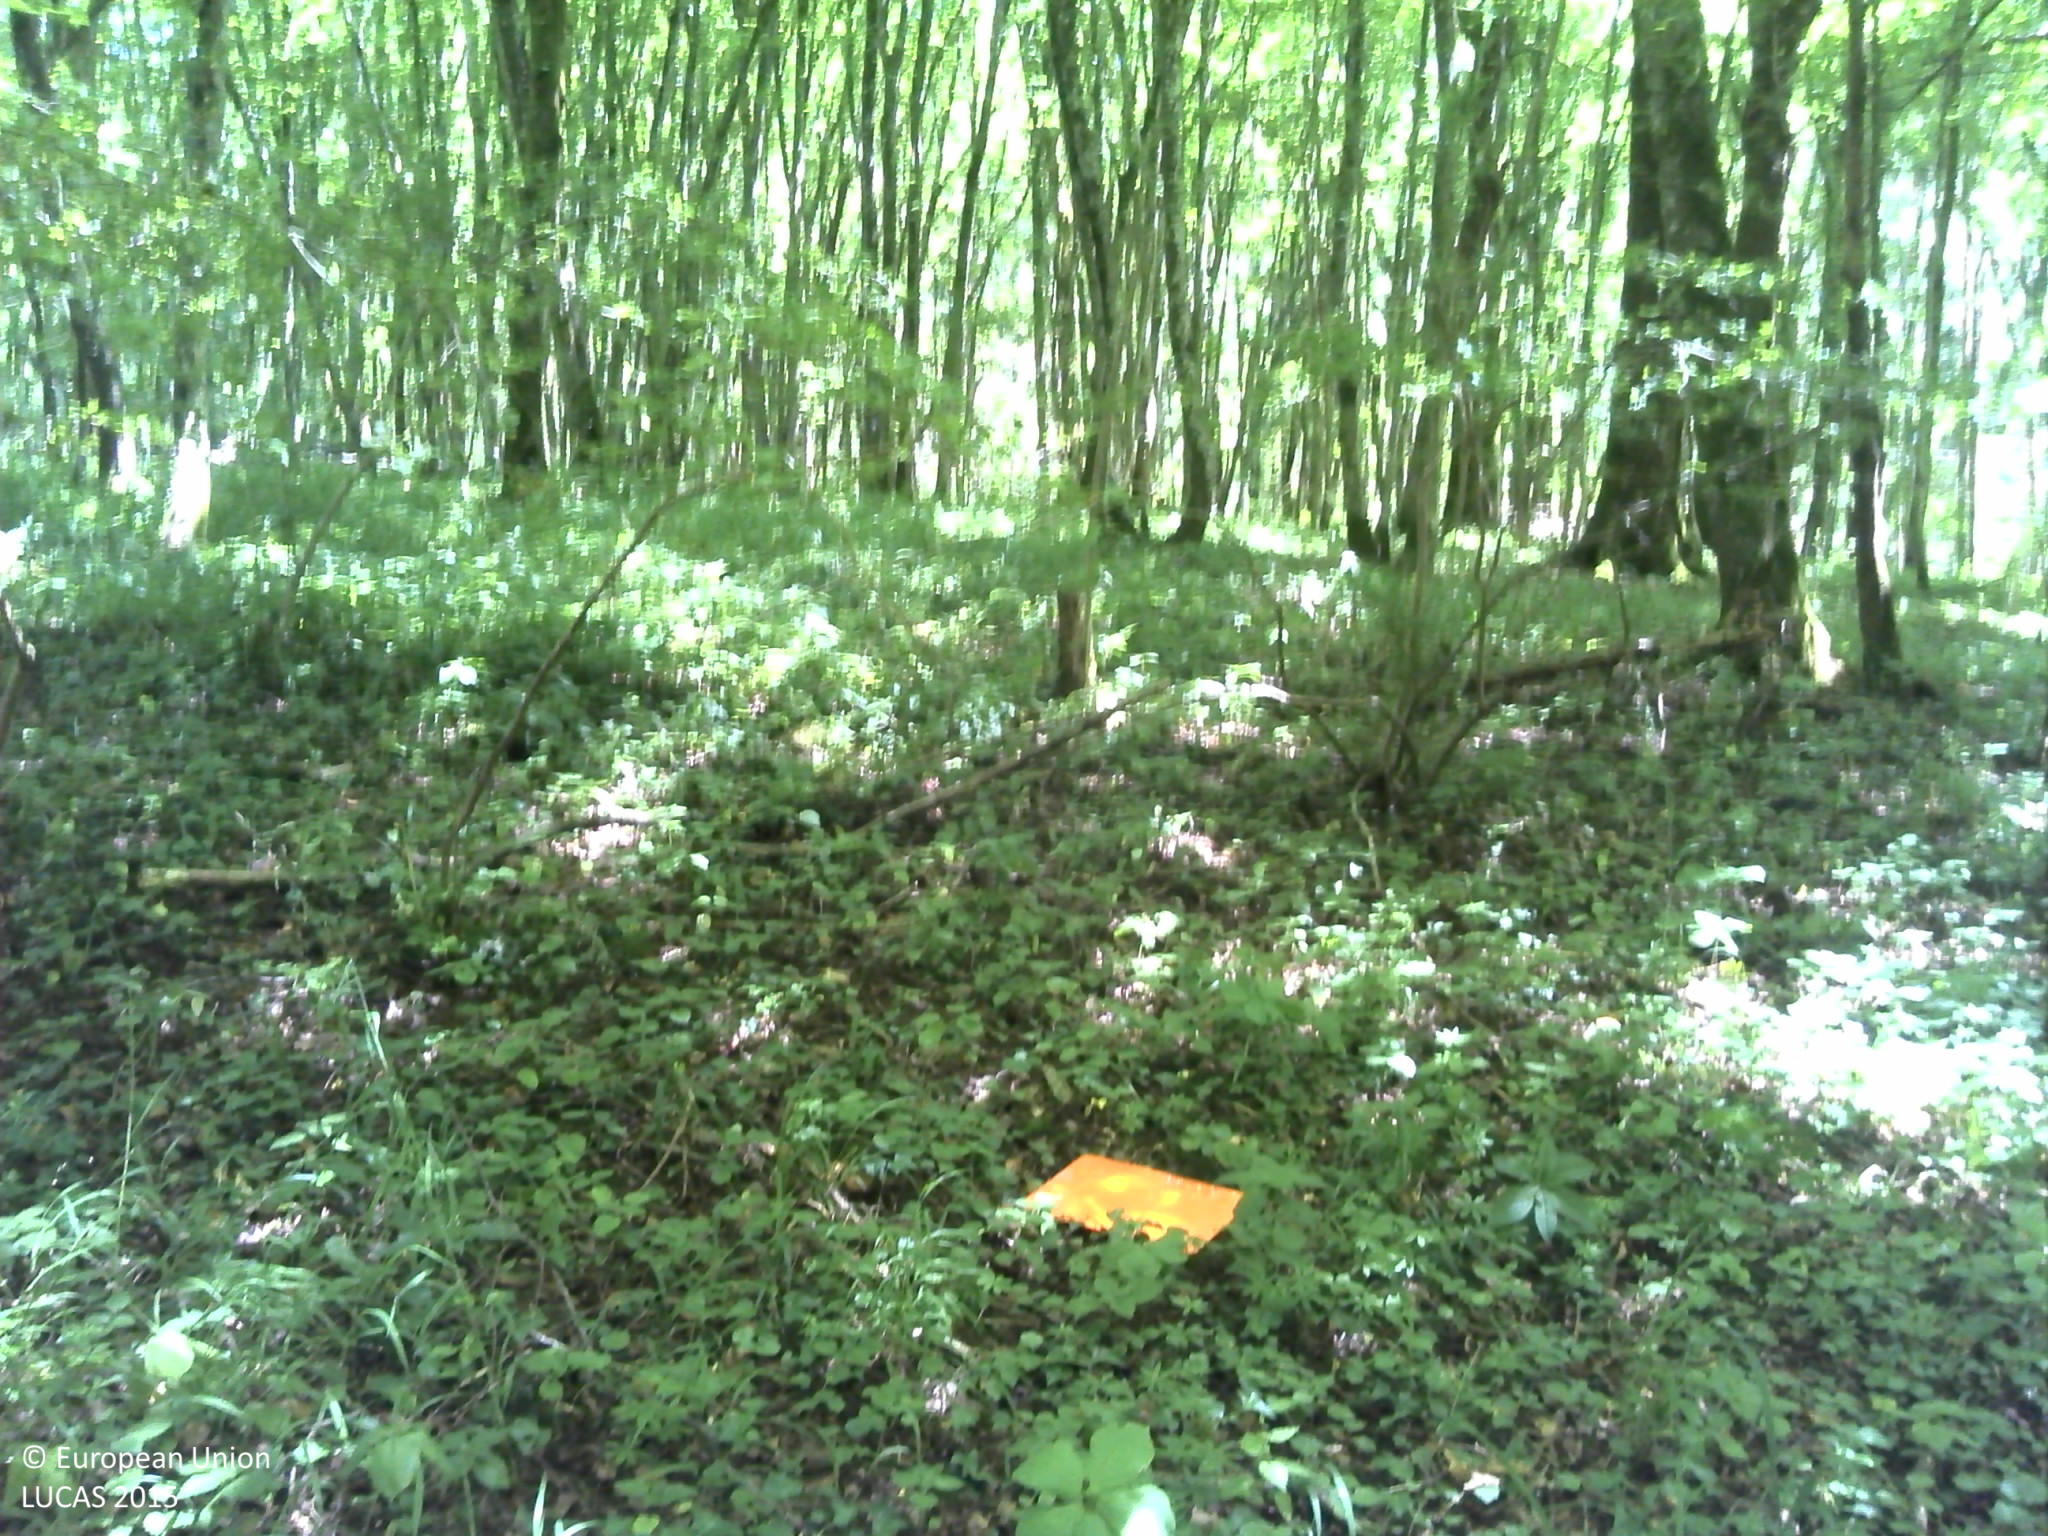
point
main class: Woodland
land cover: Broadleaved woodland
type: mesophytic deciduous forest
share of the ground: > 75 %
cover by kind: broadleaved forest trees 100 %
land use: Forestry
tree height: > 5 m
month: June
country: FR
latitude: 49.3765
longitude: 6.0189
